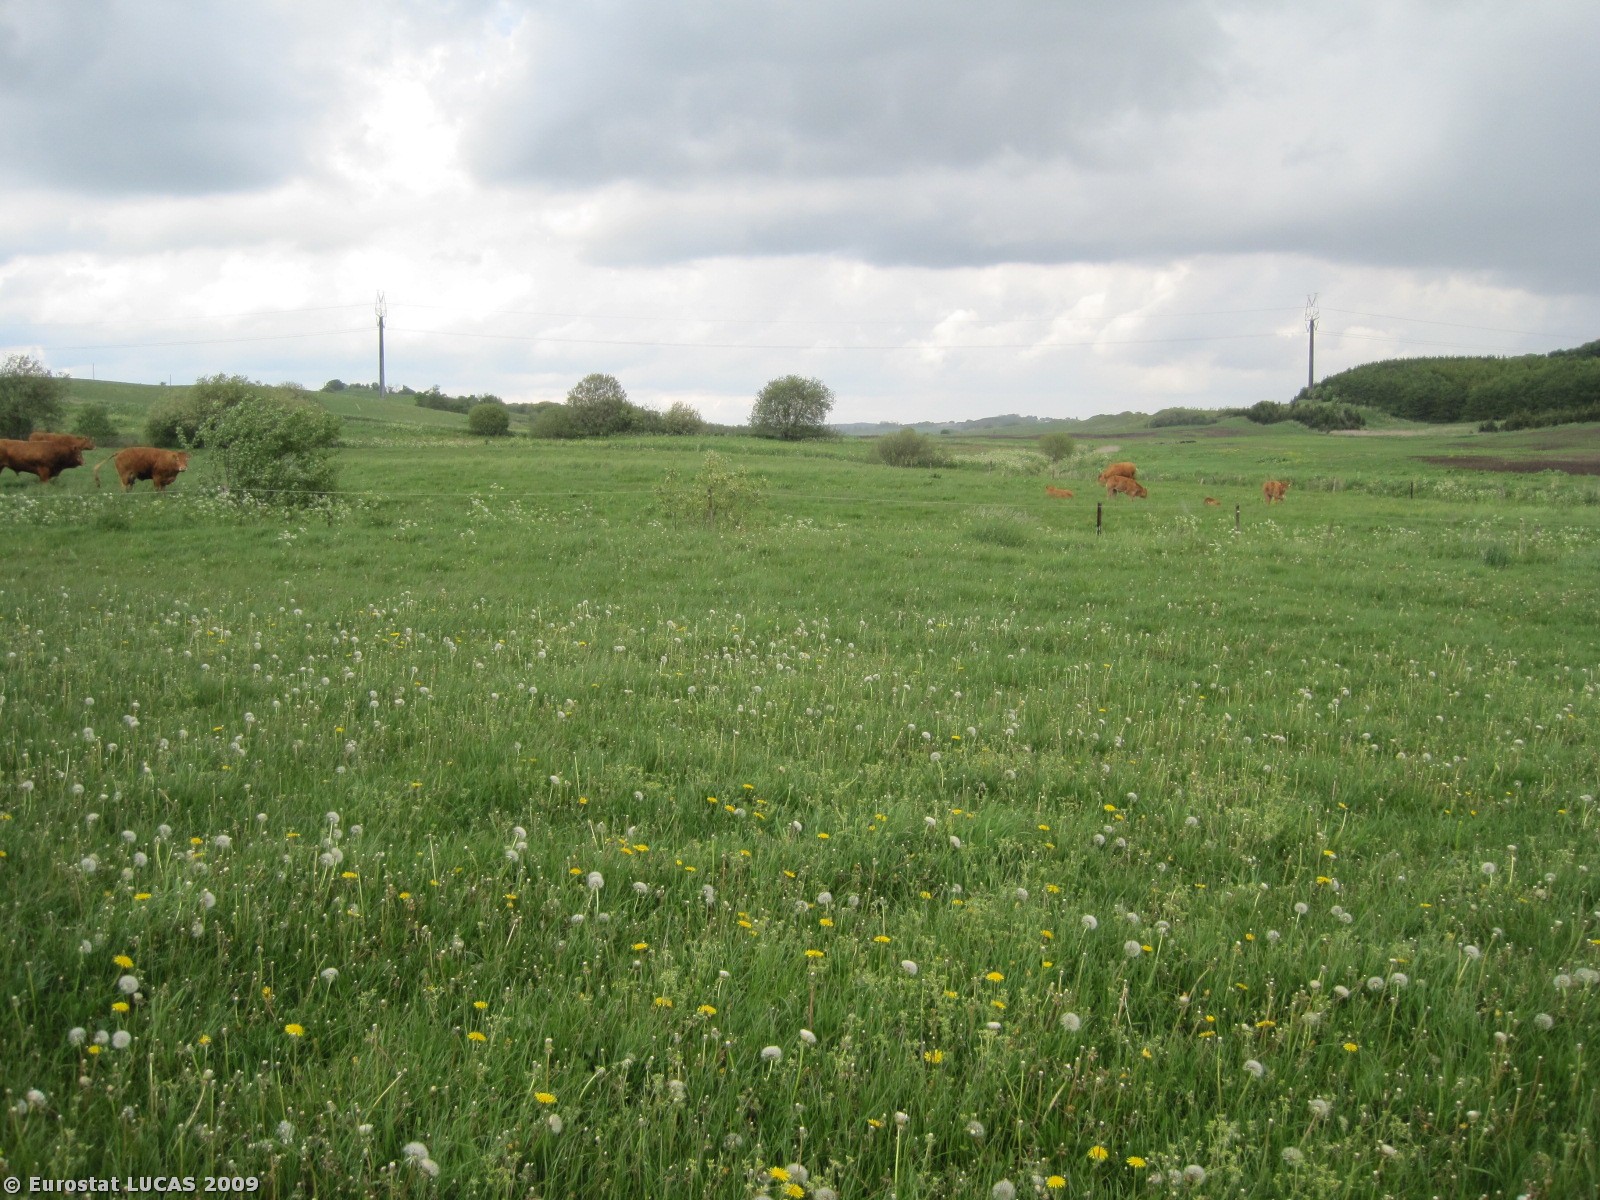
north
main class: Grassland
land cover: Grassland without tree/shrub cover
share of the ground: > 75 %
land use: Agriculture (excluding fallow land and kitchen gardens)
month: May
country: DK
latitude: 56.7268
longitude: 9.7552
